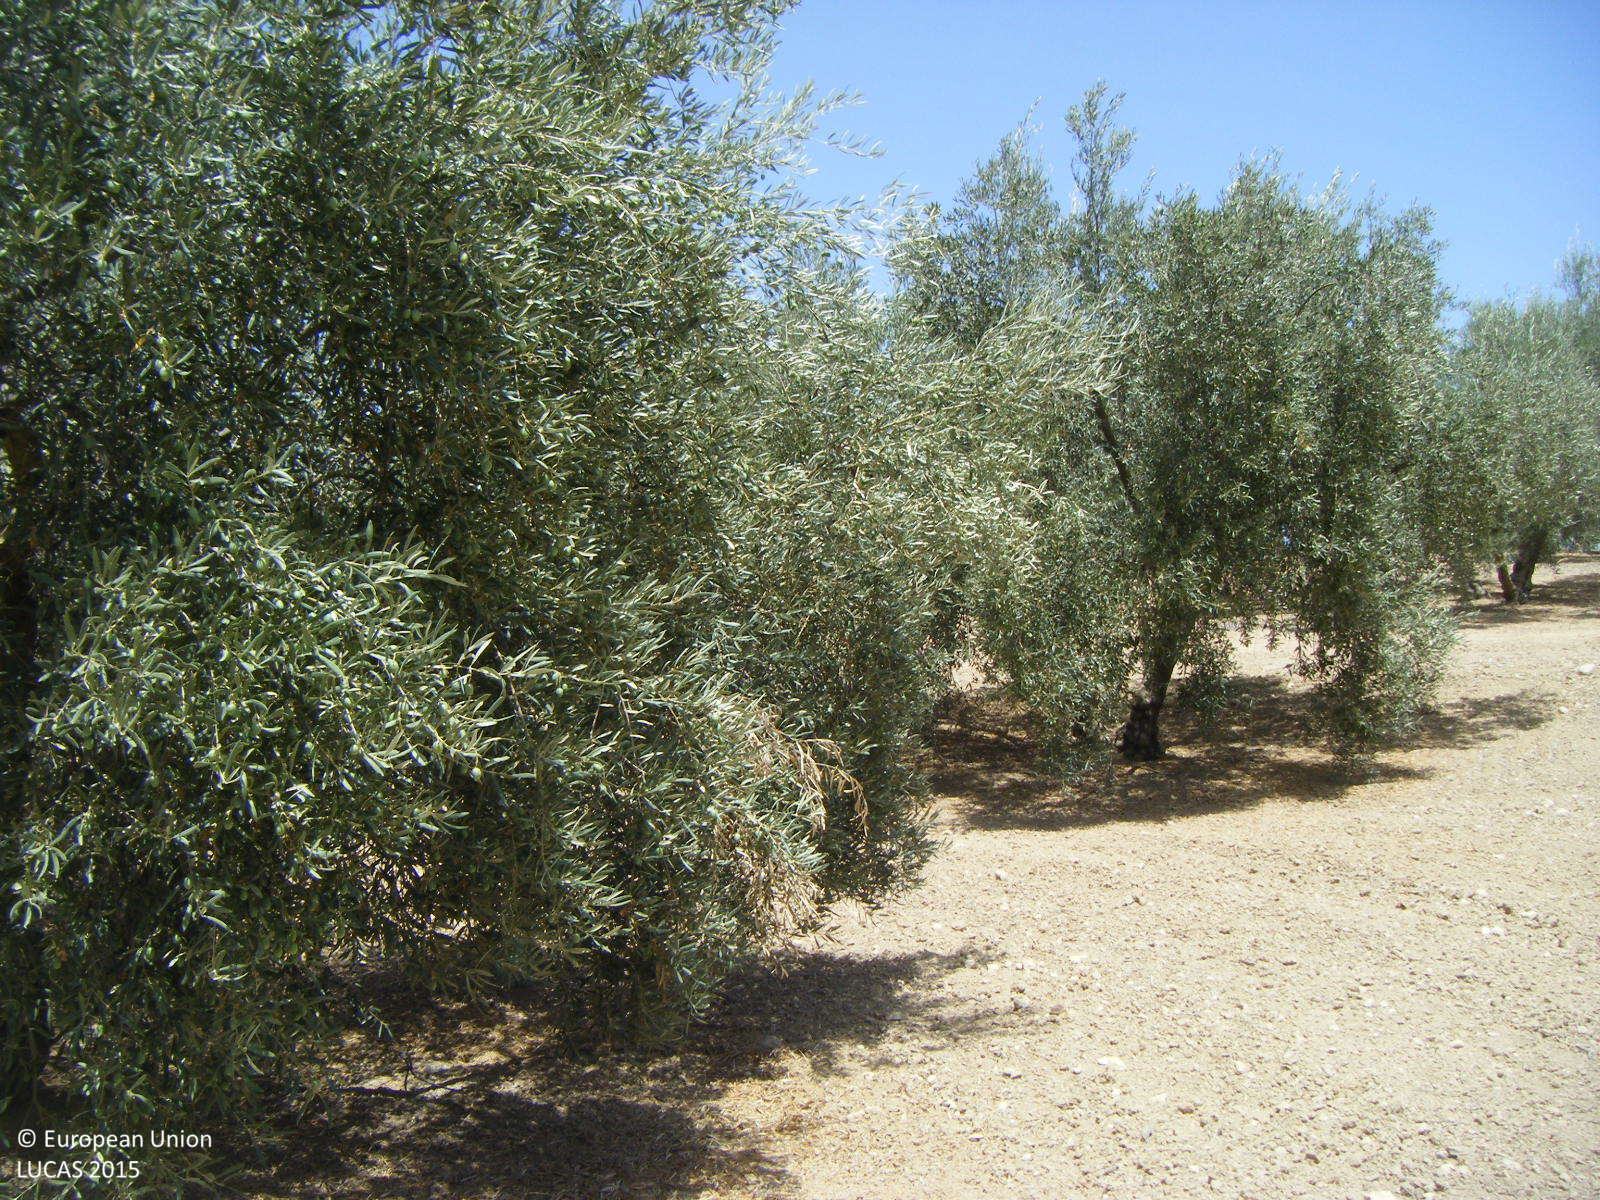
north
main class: Cropland
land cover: Olive groves
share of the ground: 25 - 50 %
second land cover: Other bare soil
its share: > 75 %
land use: Agriculture (excluding fallow land and kitchen gardens)
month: August
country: ES
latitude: 37.1360
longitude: -4.0759
